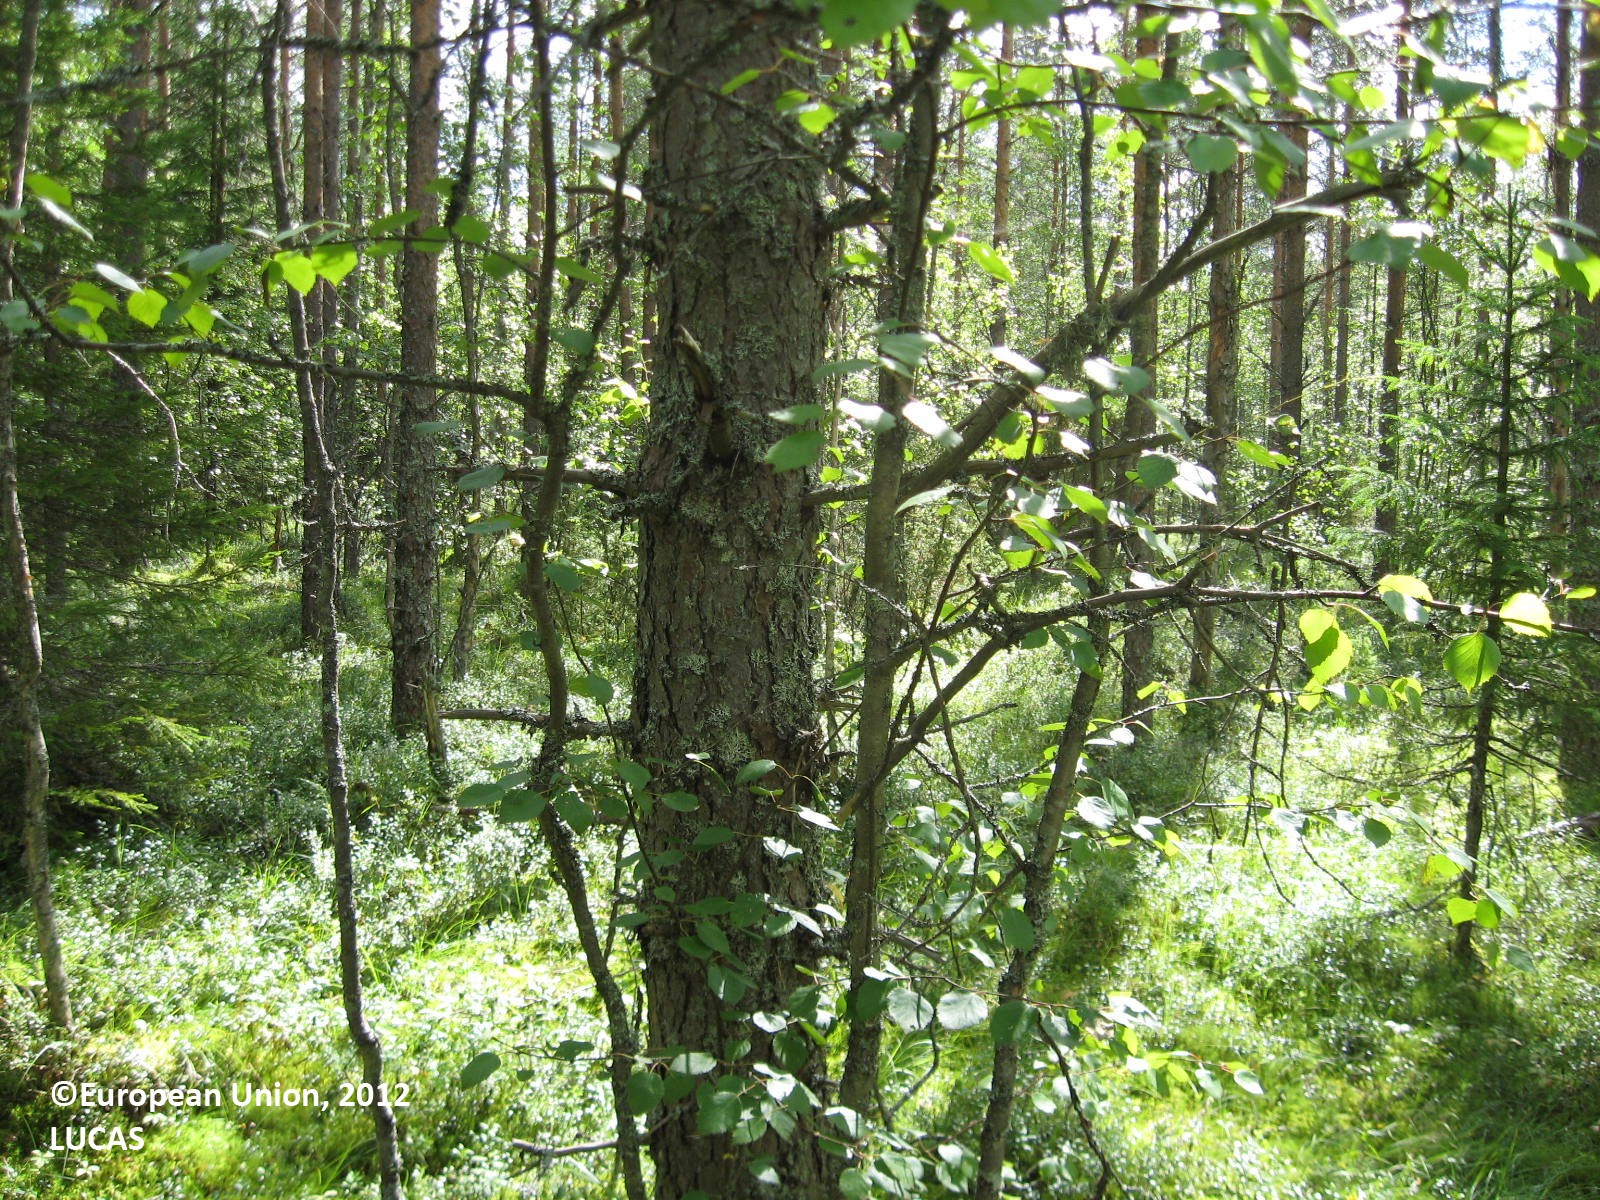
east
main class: Woodland
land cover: Pine dominated mixed woodland
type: boreal forest
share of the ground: > 75 %
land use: Forestry
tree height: > 5 m
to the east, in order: Pine dominated mixed woodland; Ditches and canals; Pine dominated mixed woodland; Ditches and canals; Spruce dominated mixed woodland
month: July
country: FI
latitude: 62.1028
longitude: 22.3371
